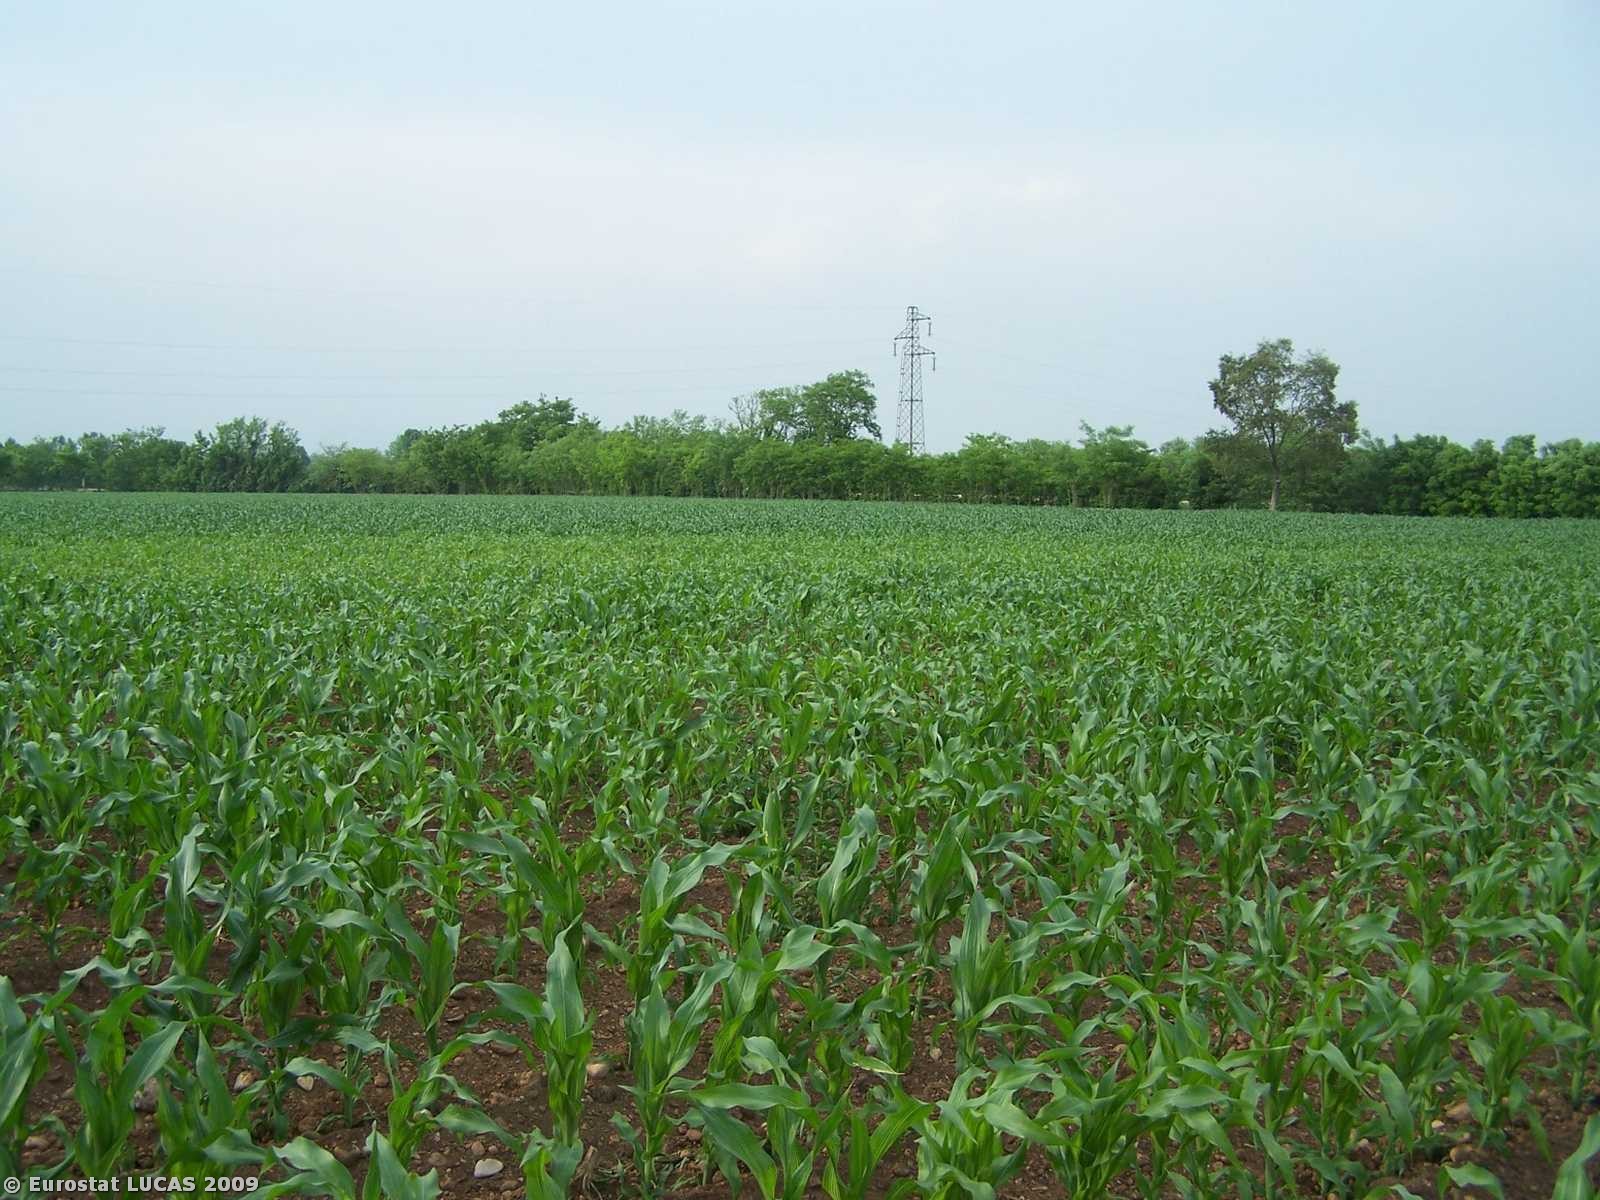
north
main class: Cropland
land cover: Maize
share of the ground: 50 - 75 %
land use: Agriculture (excluding fallow land and kitchen gardens)
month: May
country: IT
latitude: 45.9853
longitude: 12.9784
